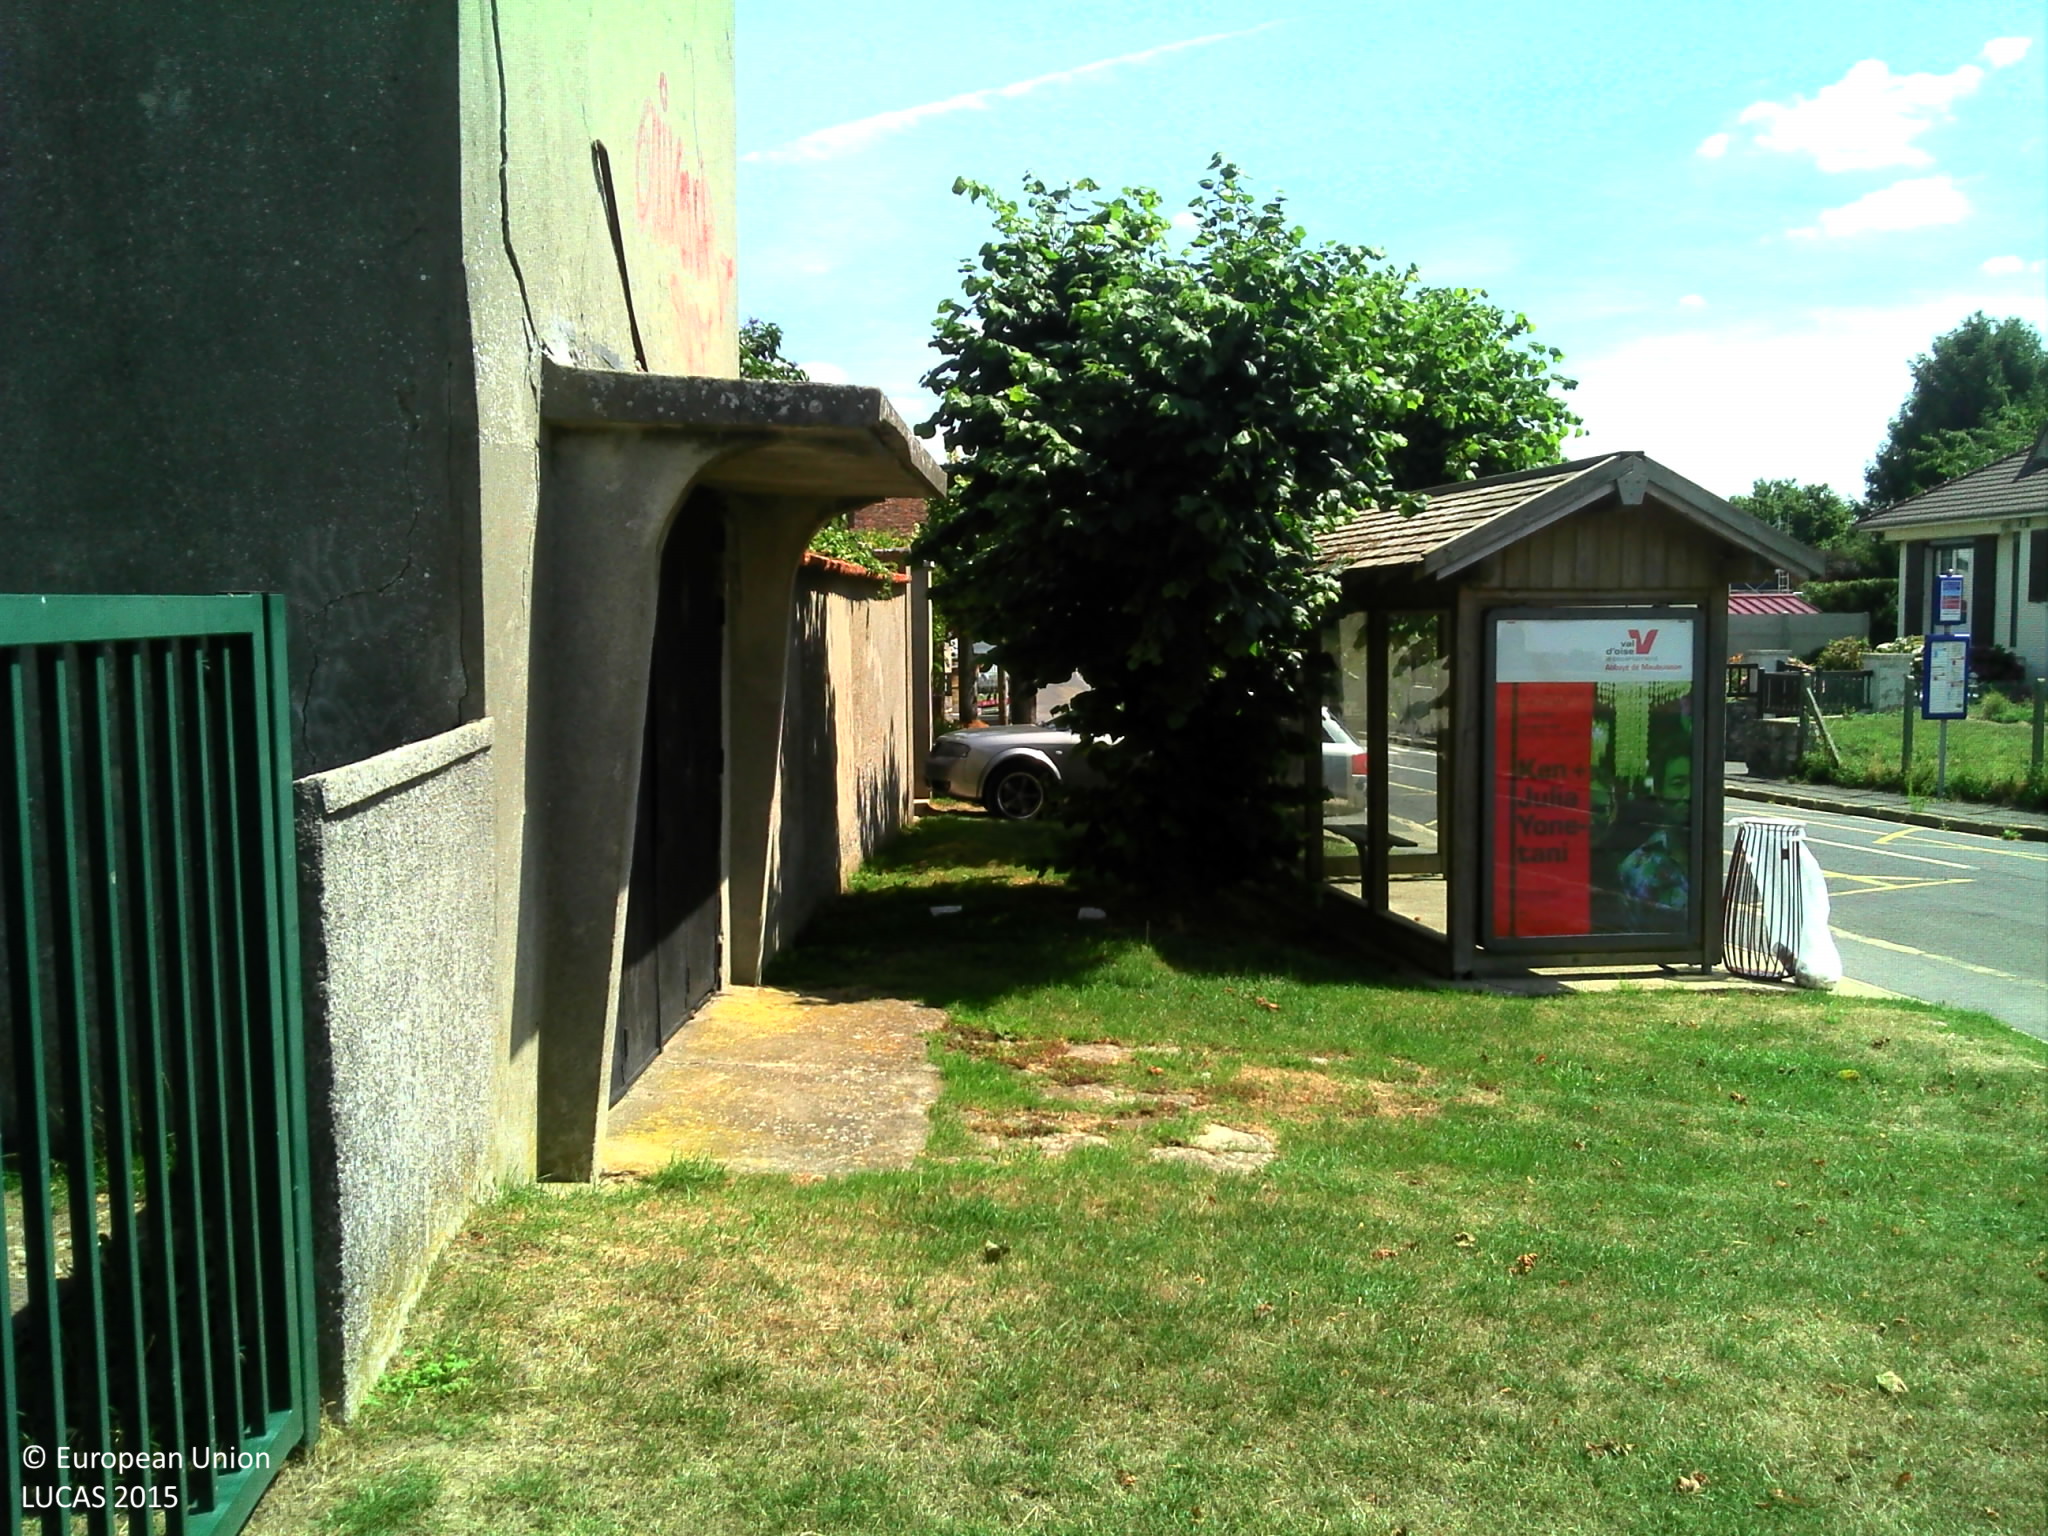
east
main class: Woodland
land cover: Broadleaved woodland
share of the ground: > 75 %
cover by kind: broadleaved forest trees 85 %, herbaceous plants 15 %
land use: Residential
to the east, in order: Broadleaved woodland; Artificial constructions in urban areas
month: July
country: FR
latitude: 49.0683
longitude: 2.4738
